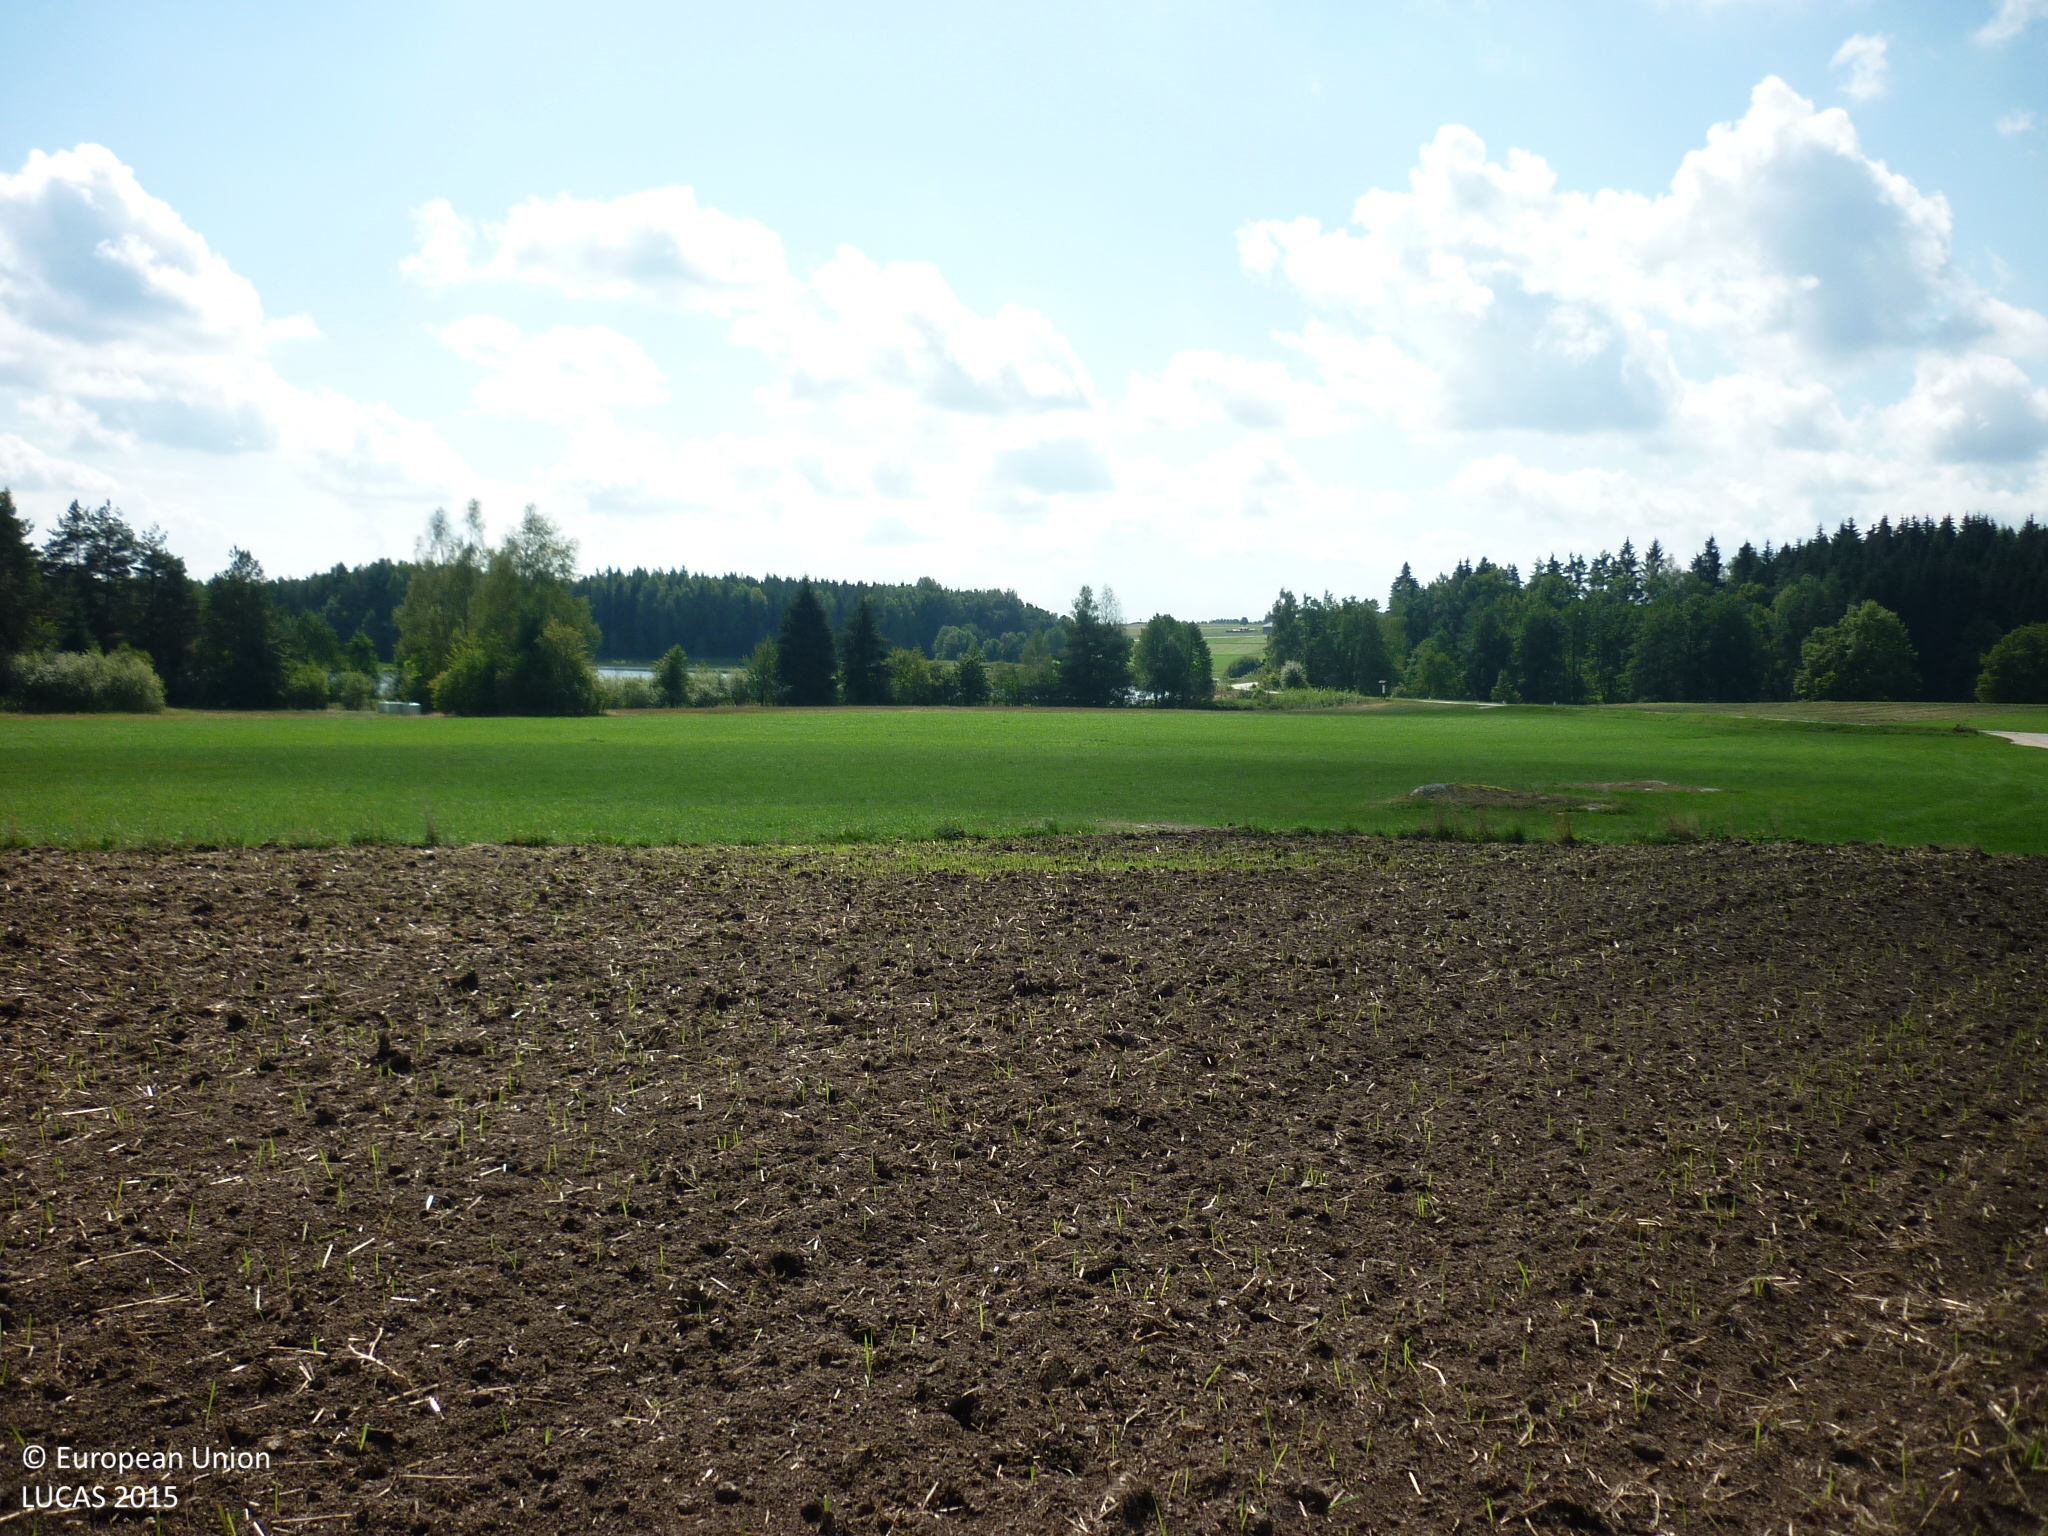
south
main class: Cropland
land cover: Rye
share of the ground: < 10 %
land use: Agriculture (excluding fallow land and kitchen gardens)
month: September
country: AT
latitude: 48.9710
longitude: 15.0978
